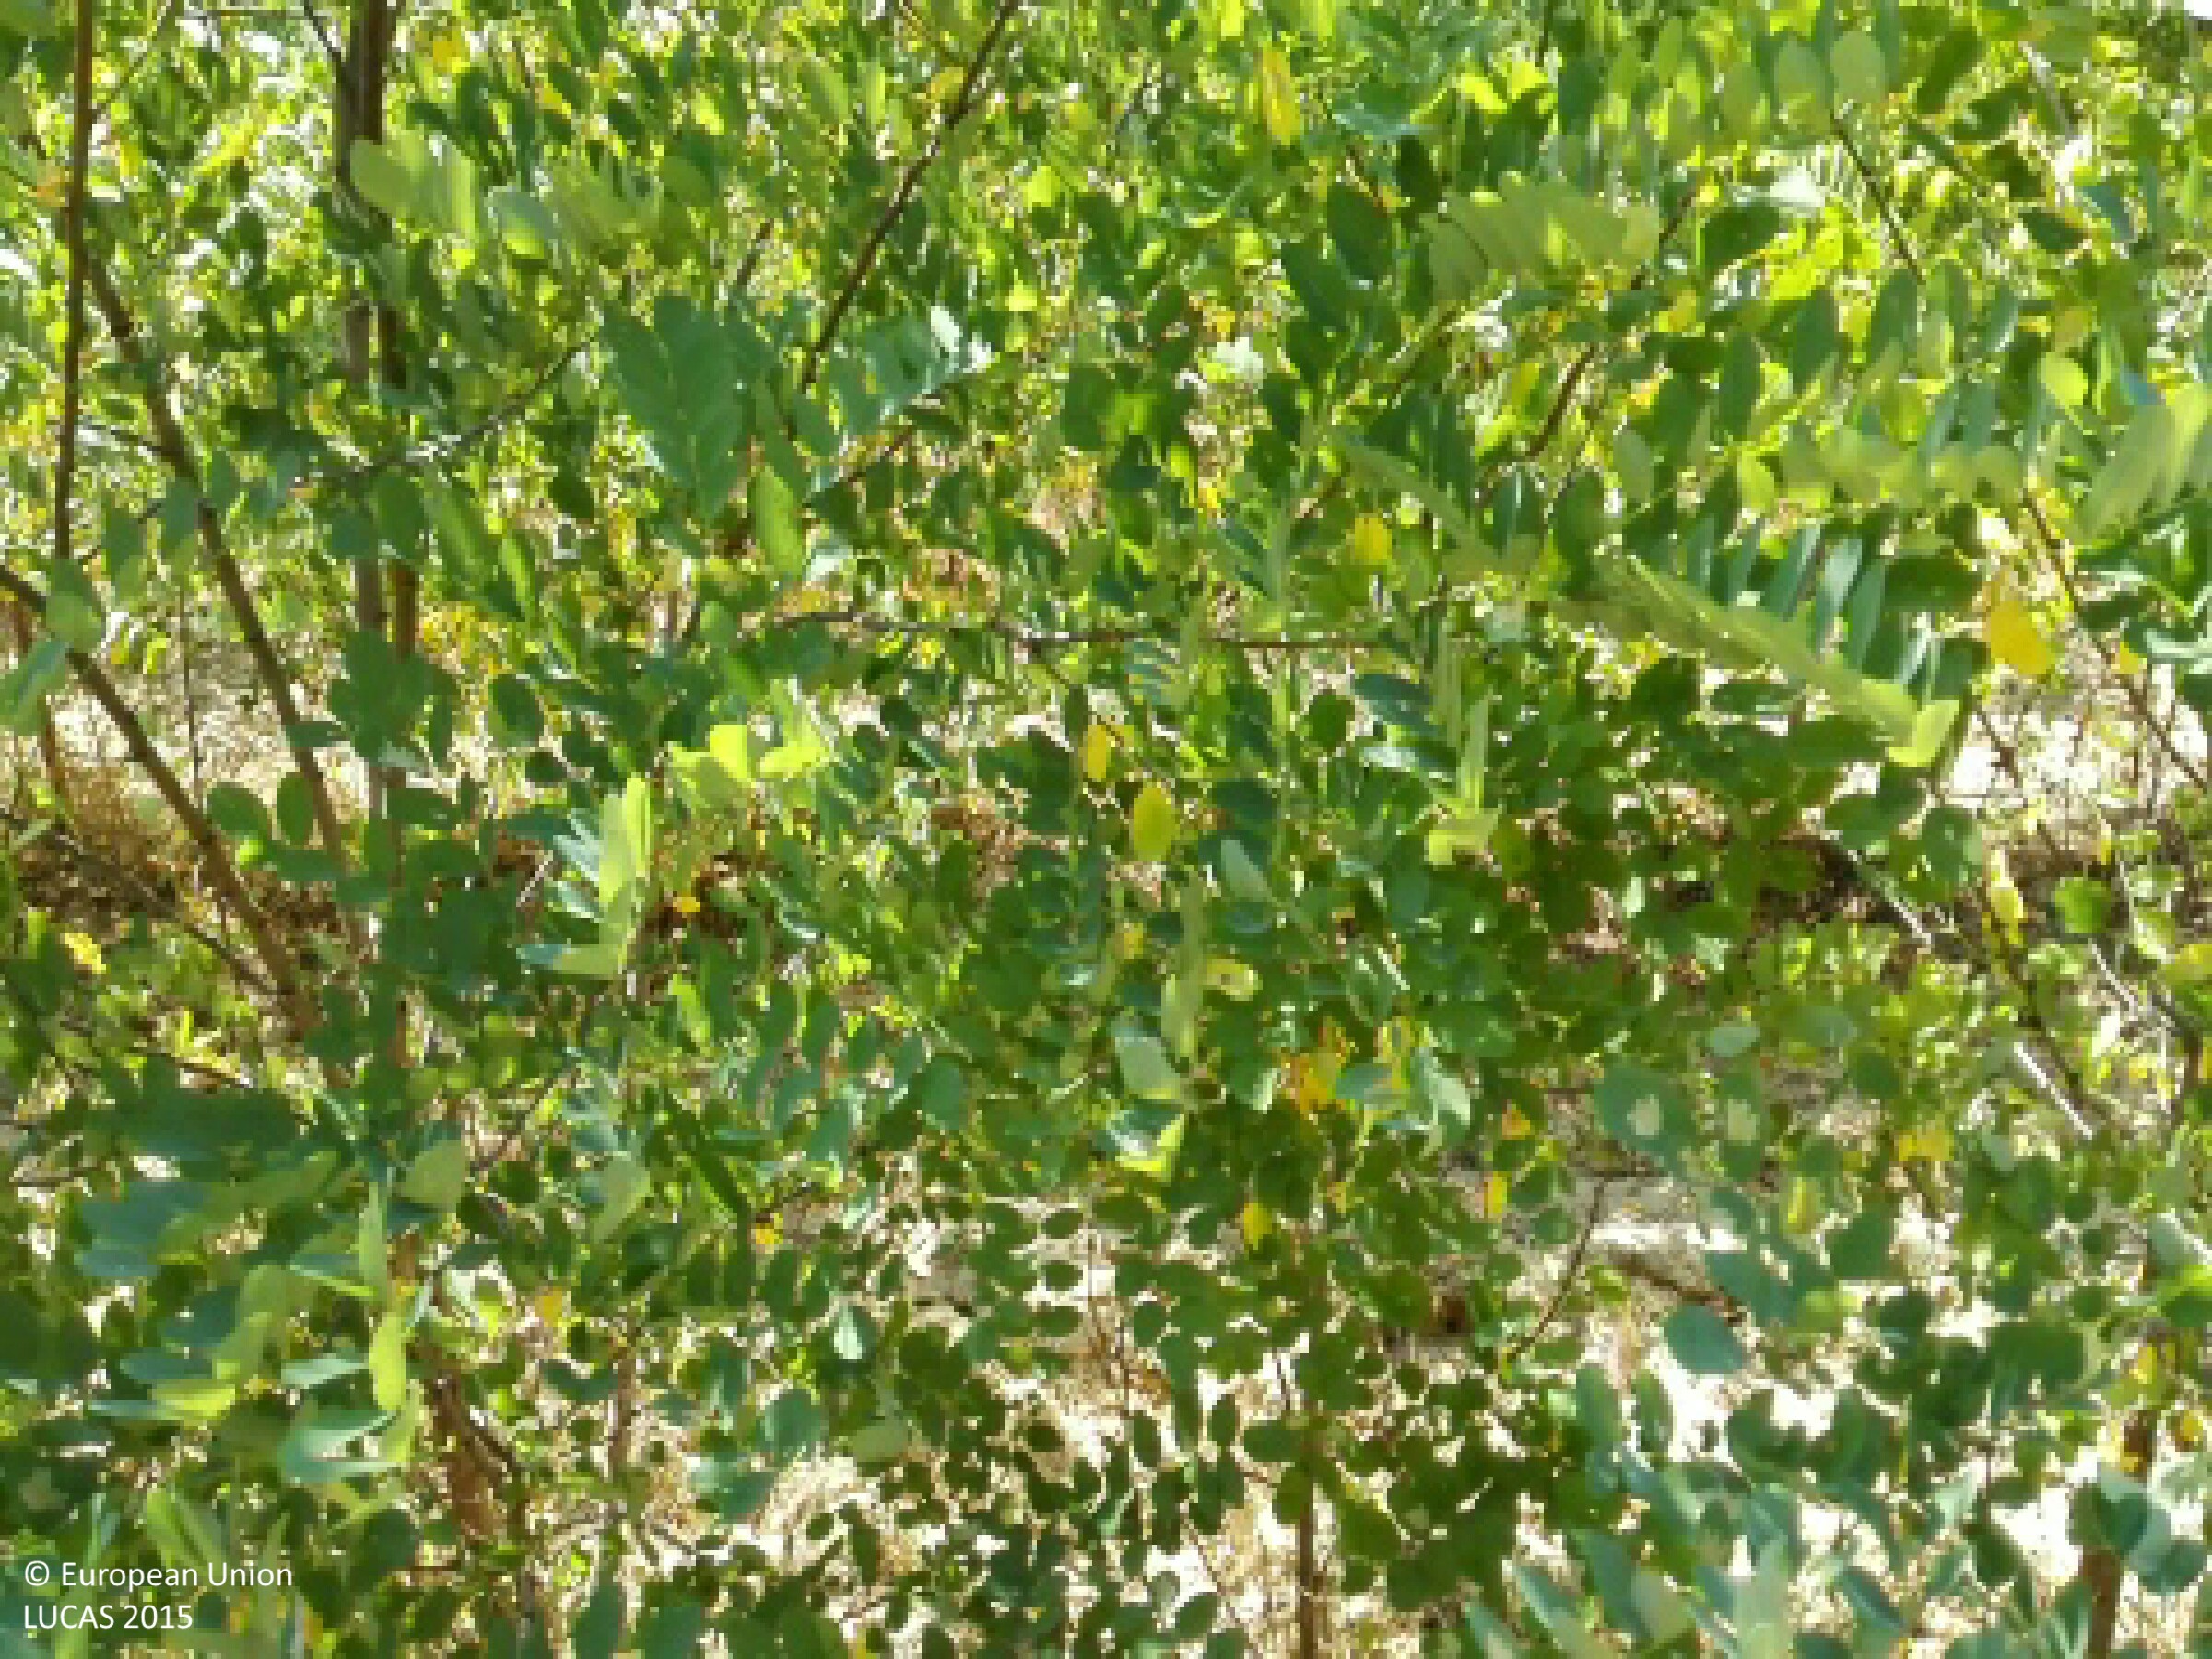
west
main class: Woodland
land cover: Broadleaved woodland
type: thermophilous deciduous forest
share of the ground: > 75 %
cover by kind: broadleaved forest trees 100 %
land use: Forestry
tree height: < 5 m
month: July
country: HU
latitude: 47.6205
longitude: 21.6613
